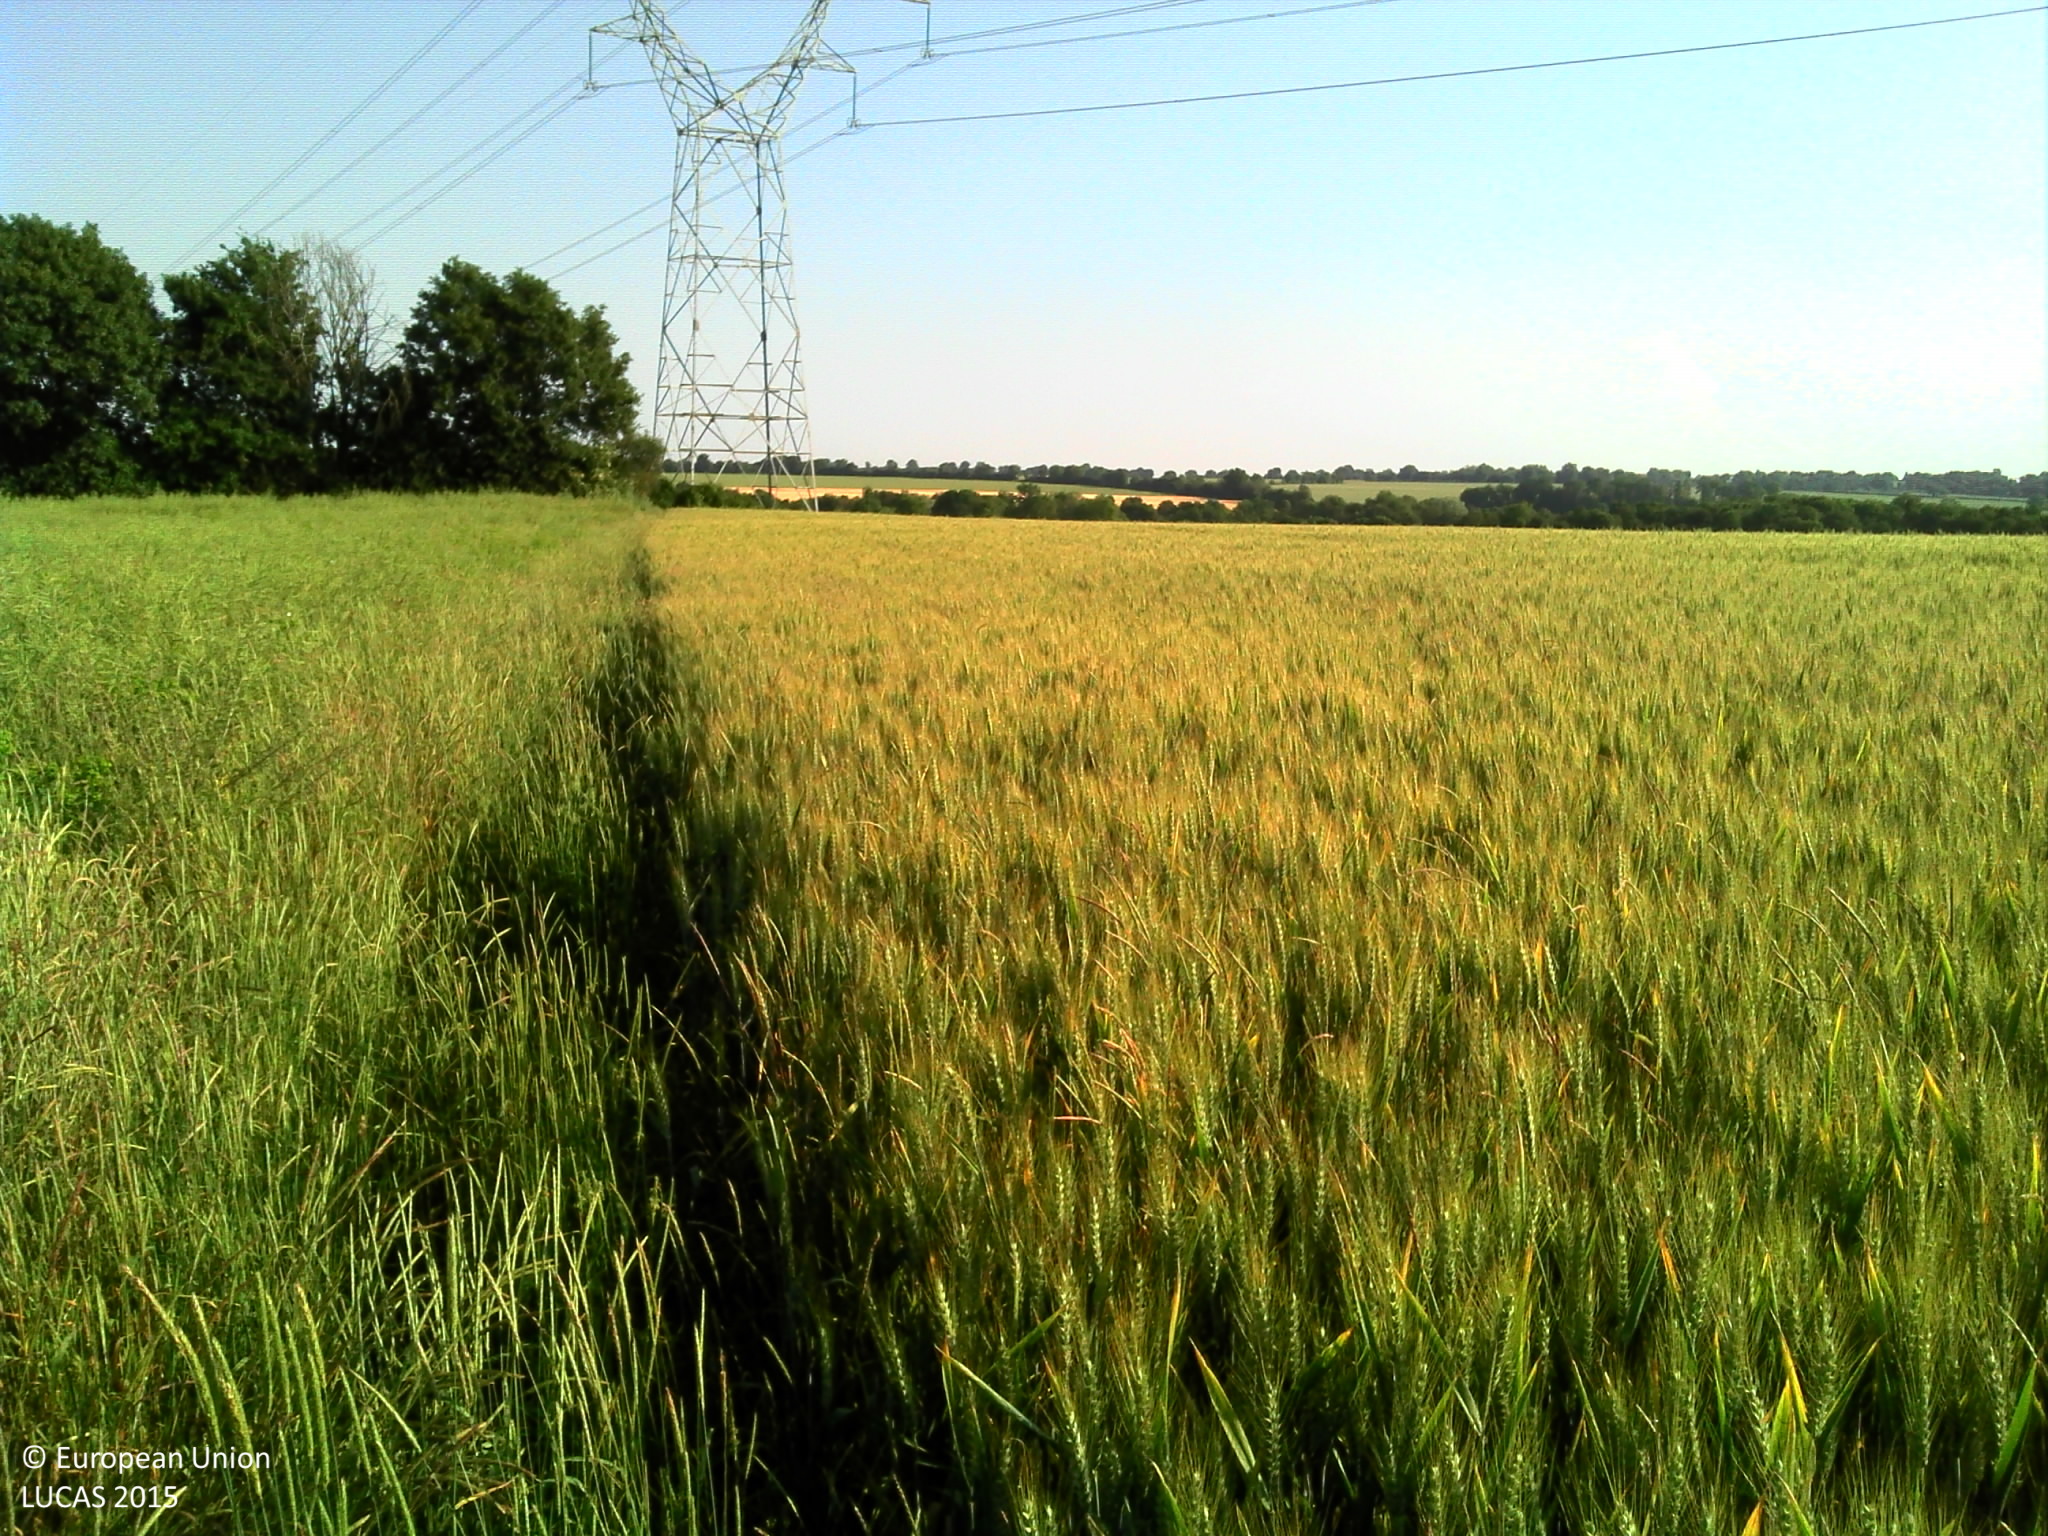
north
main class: Cropland
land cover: Common wheat
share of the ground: > 75 %
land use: Agriculture (excluding fallow land and kitchen gardens)
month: June
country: FR
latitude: 46.7418
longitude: 2.8102
